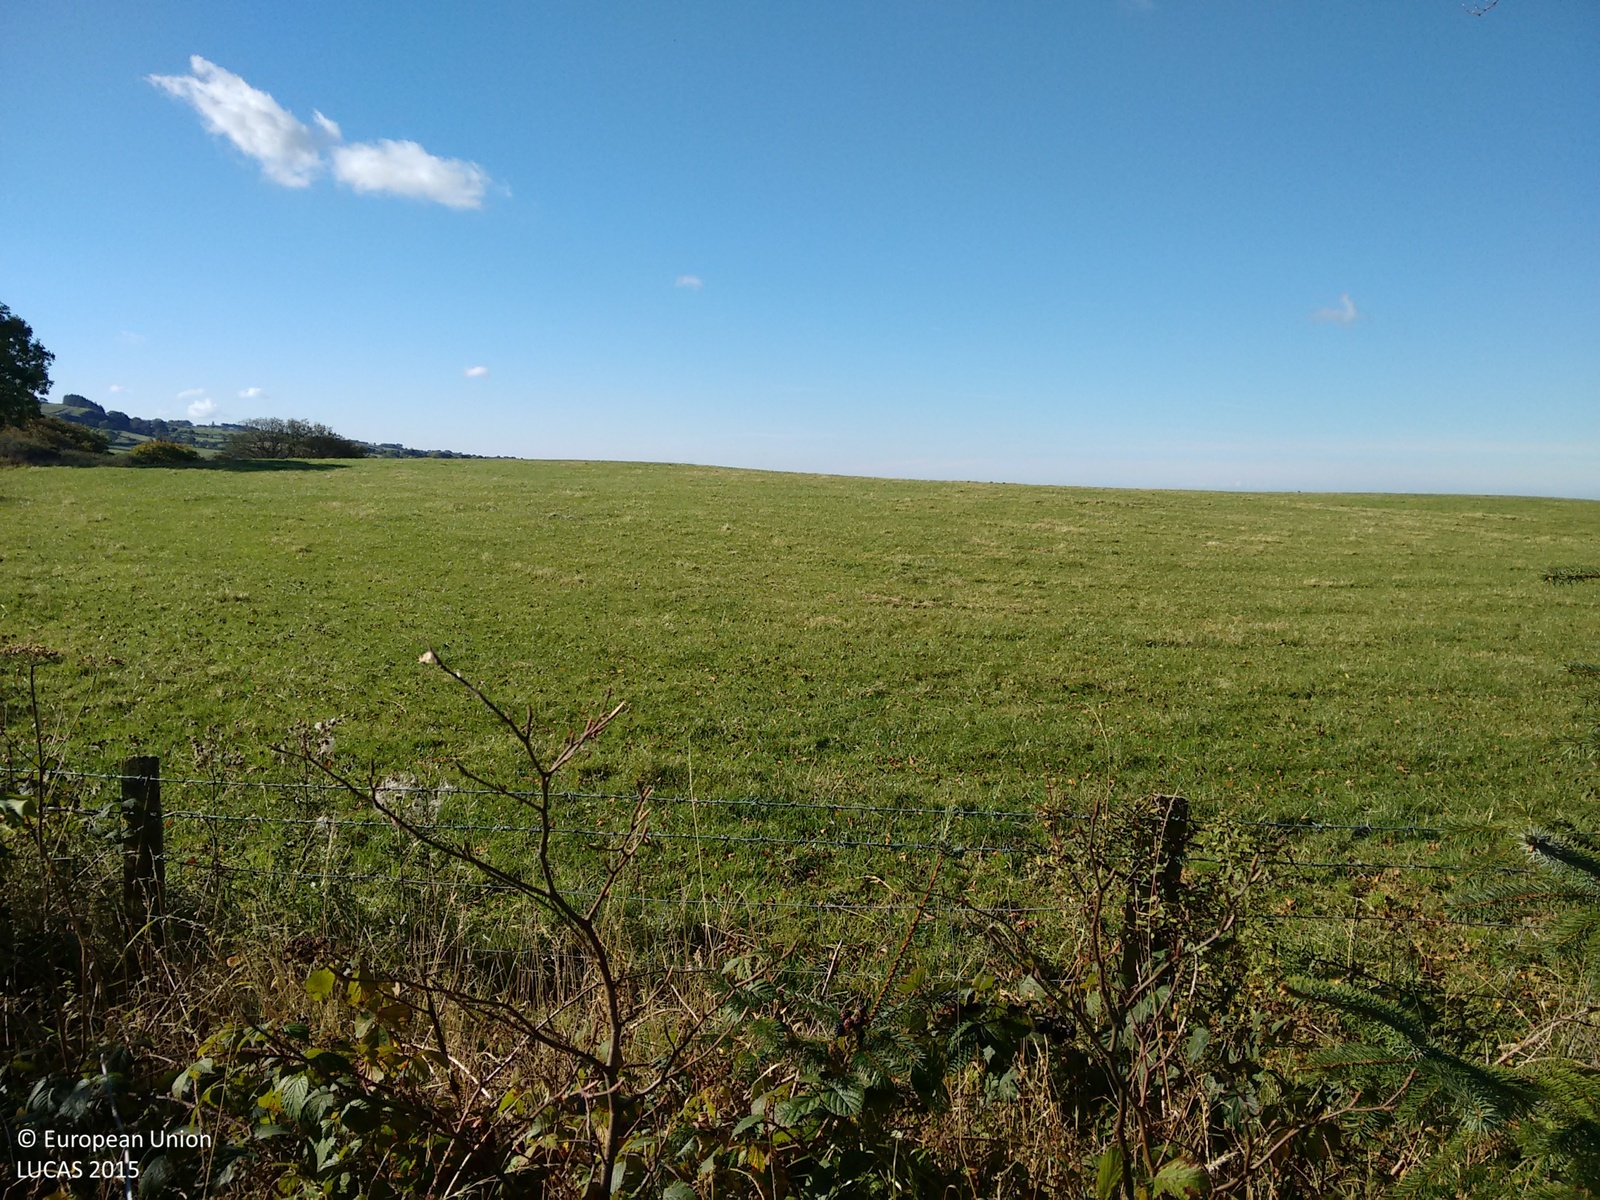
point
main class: Grassland
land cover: Grassland without tree/shrub cover
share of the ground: > 75 %
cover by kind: herbaceous plants 100 %
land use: Agriculture (excluding fallow land and kitchen gardens)
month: October
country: GB
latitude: 52.3252
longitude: -4.0192
